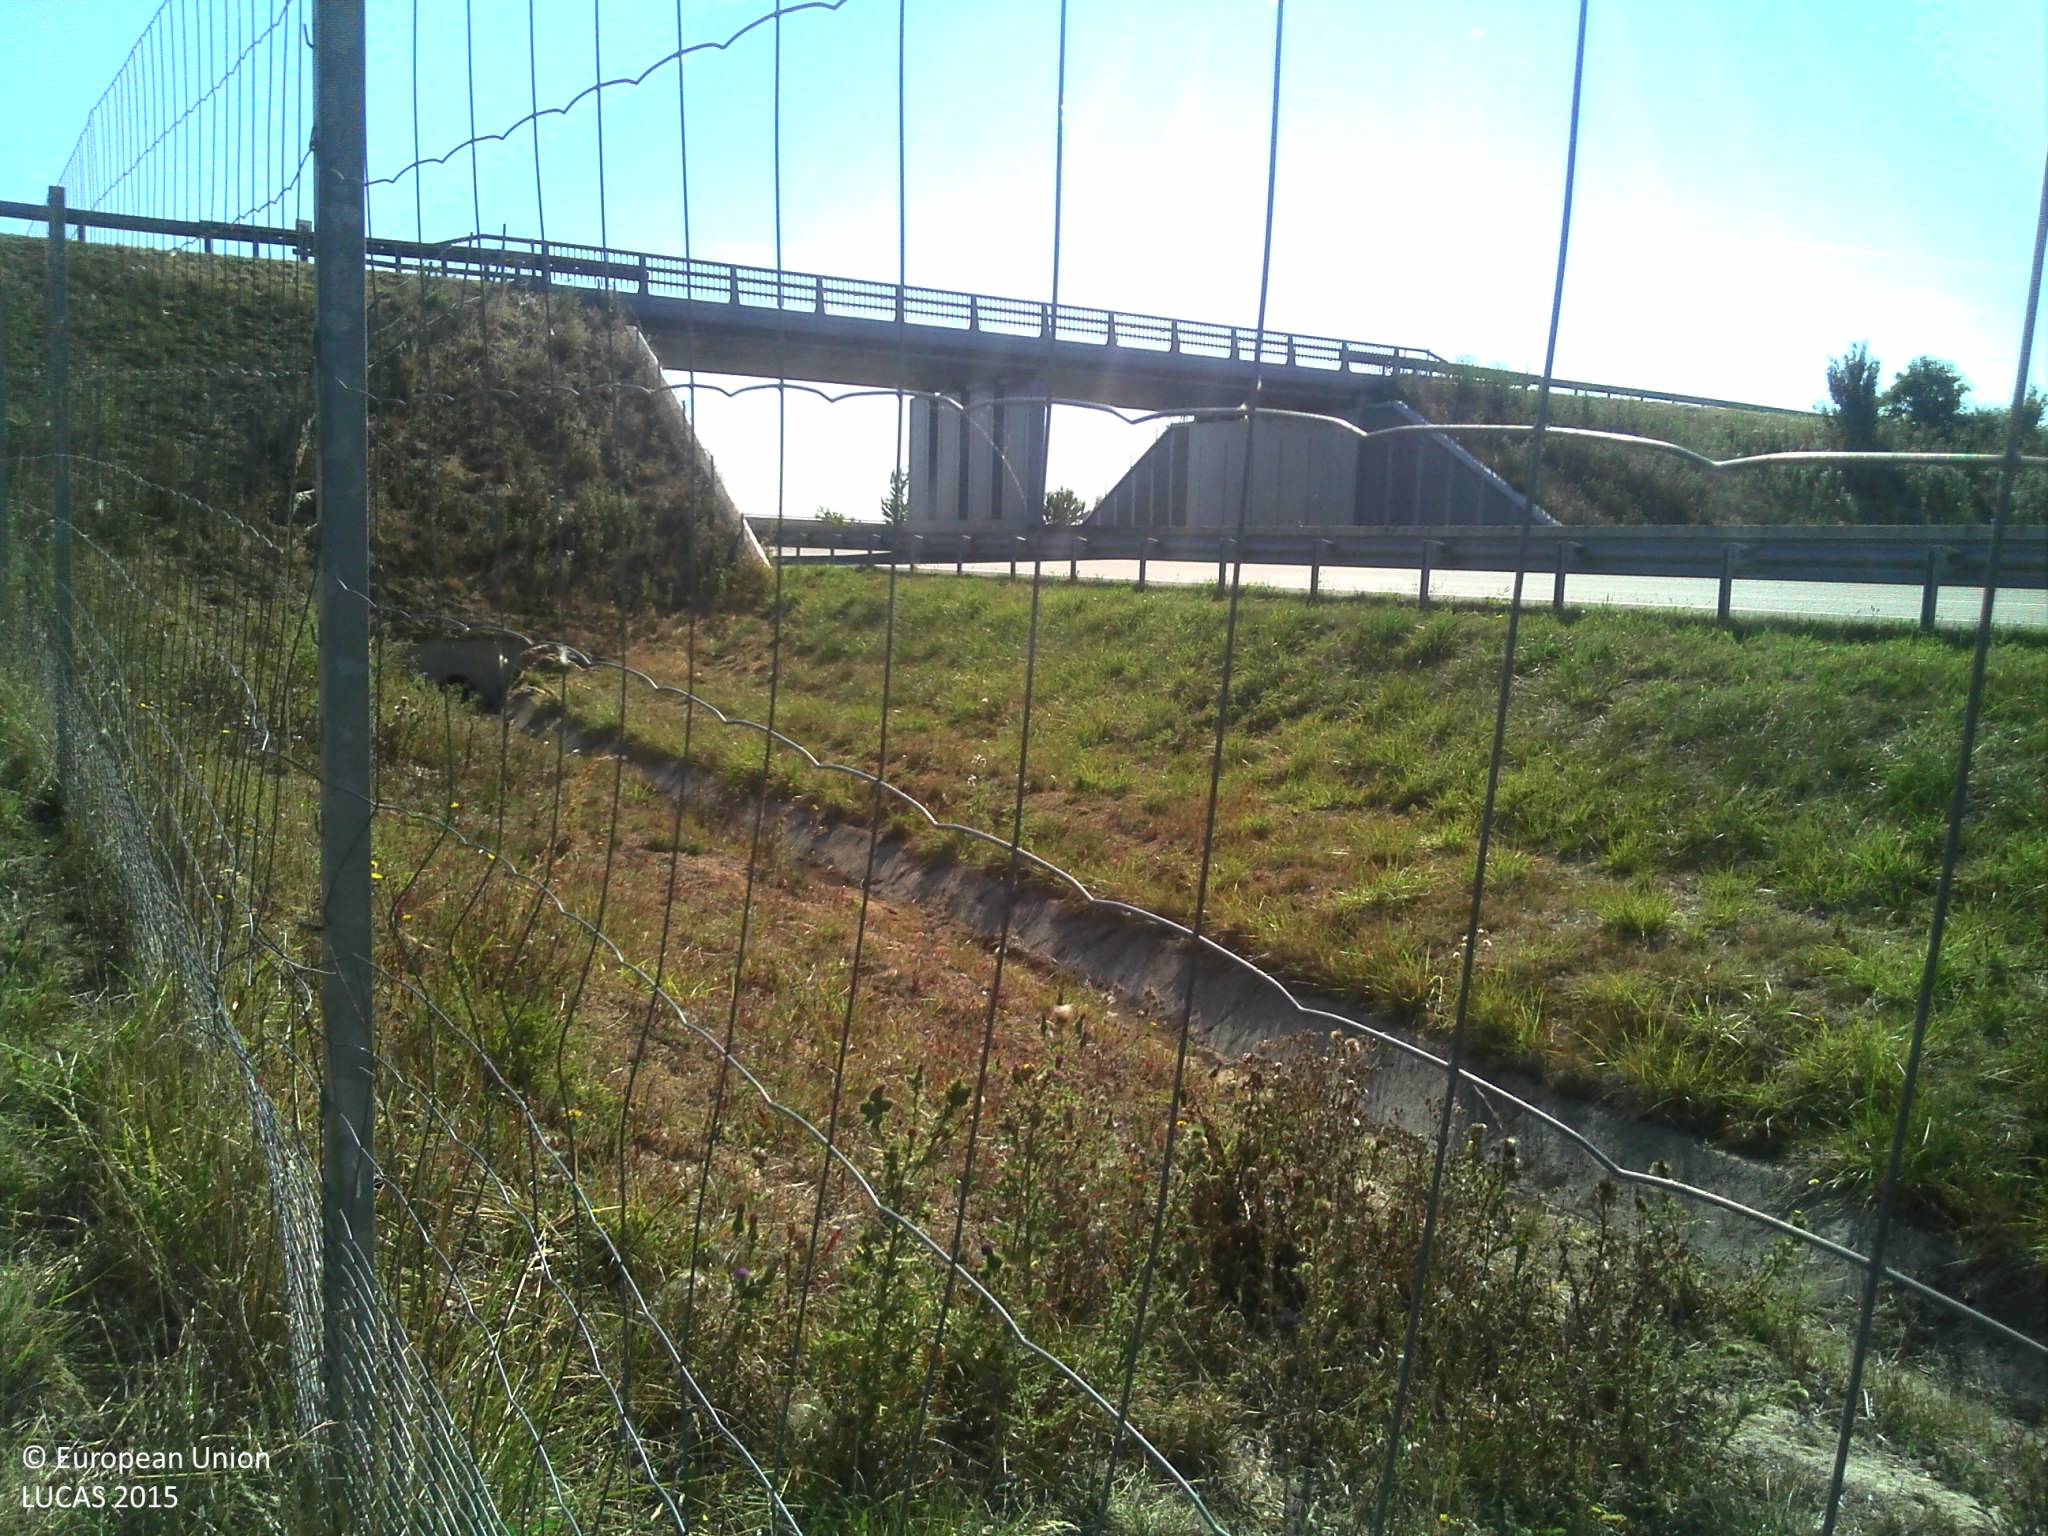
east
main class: Grassland
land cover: Grassland without tree/shrub cover
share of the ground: > 75 %
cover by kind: herbaceous plants 100 %
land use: Road transport
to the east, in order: Grassland without tree/shrub cover; Paved roads, cycling and walking lanes; Grass margins; Ditches and canals; Fences; Spontaneously vegetated surfaces; Durum wheat
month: August
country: FR
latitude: 48.0971
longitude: 2.0250
